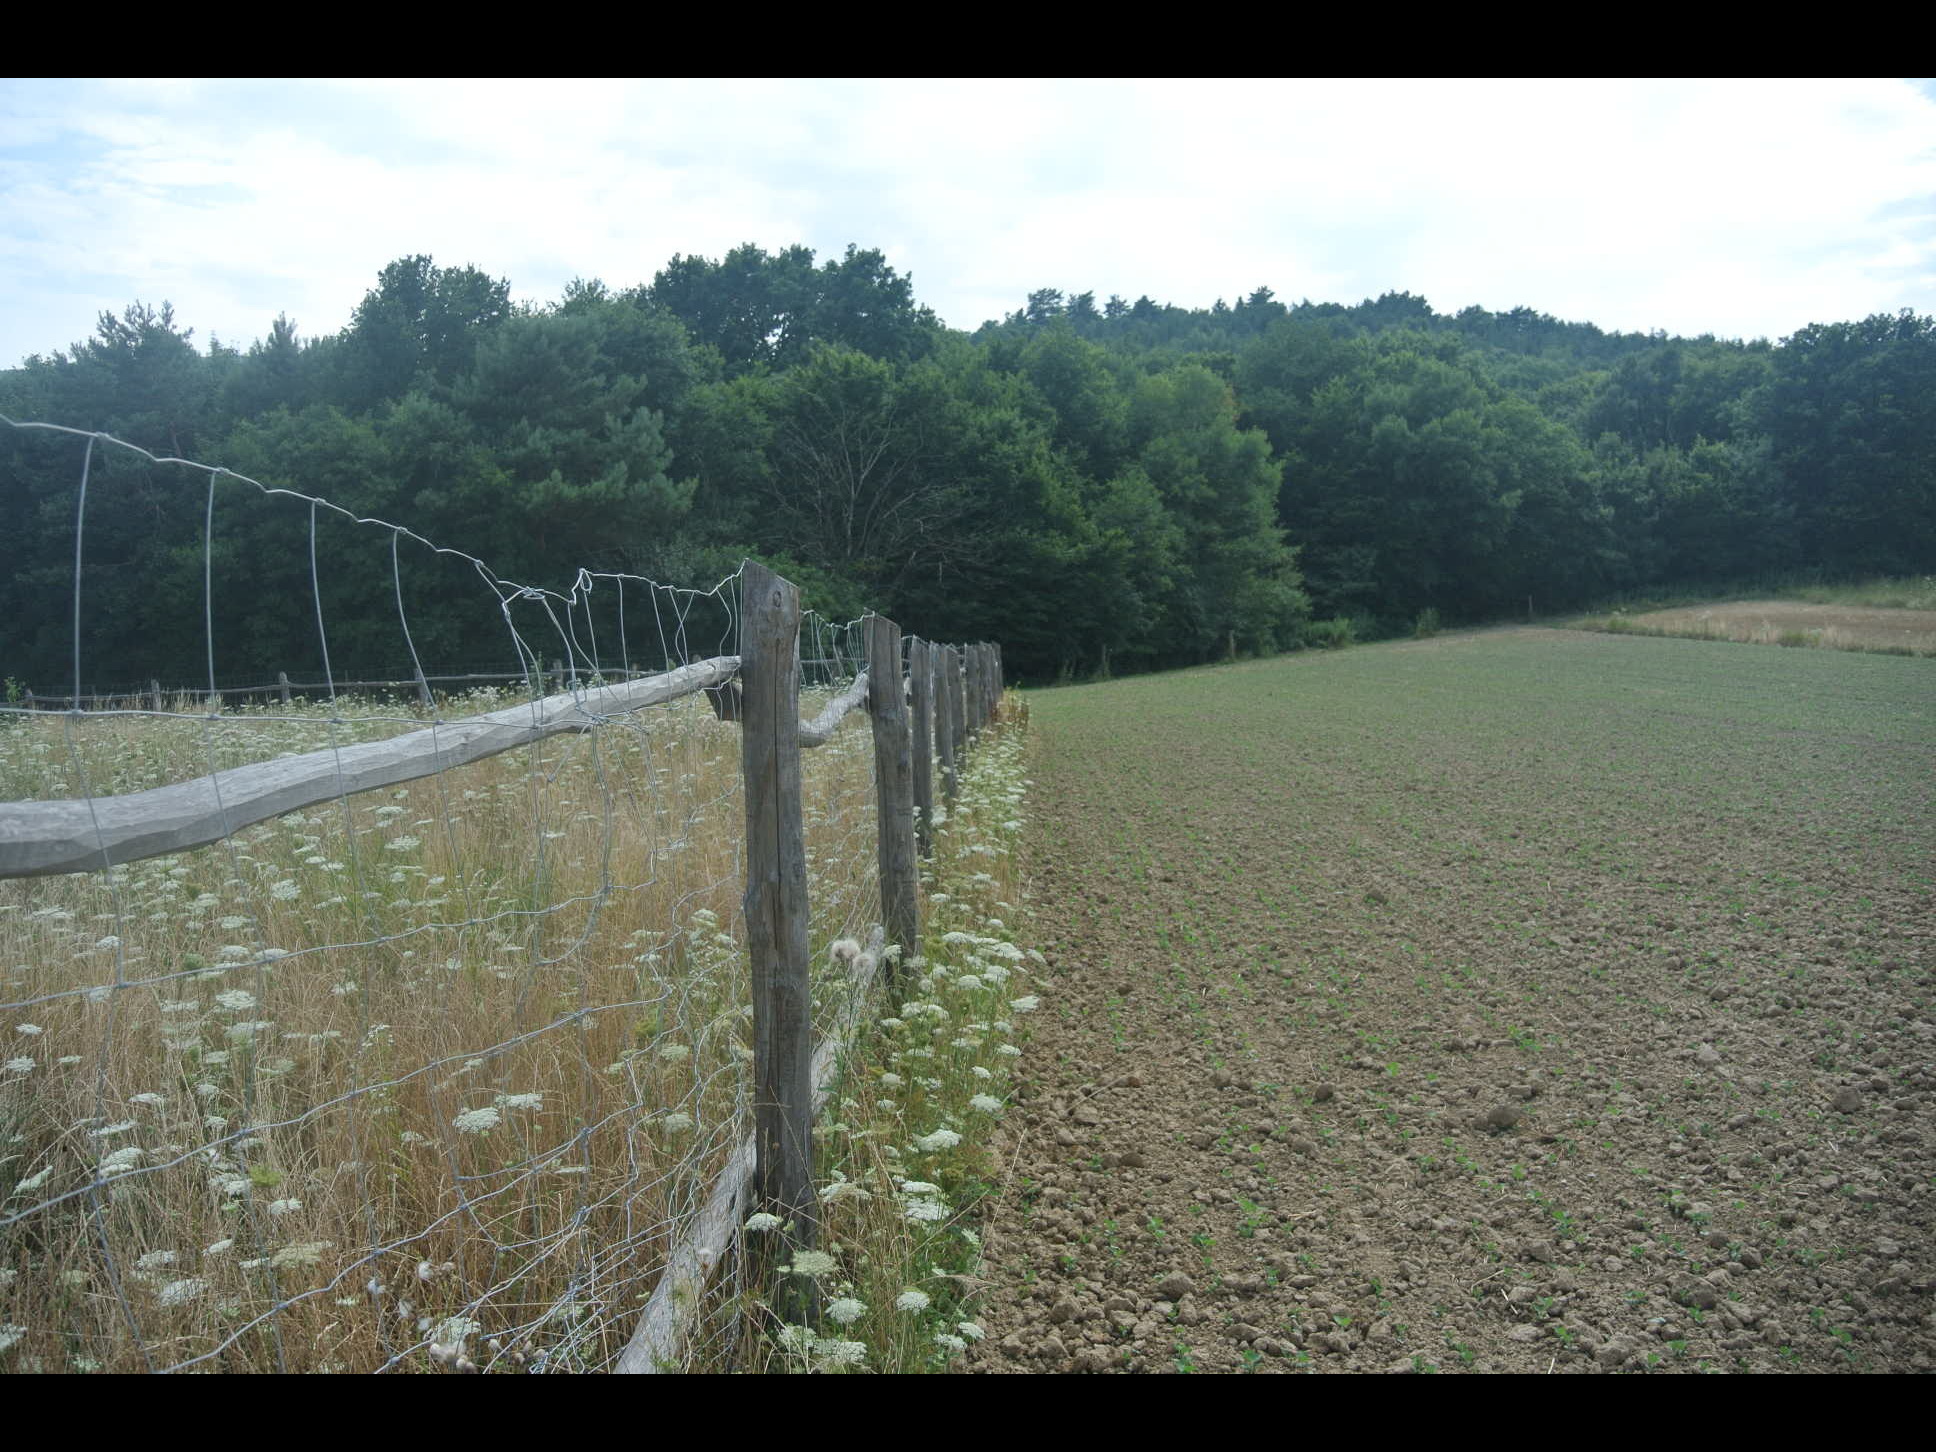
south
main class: Cropland
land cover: Apple fruit
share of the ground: < 10 %
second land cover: Grassland without tree/shrub cover
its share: > 75 %
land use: Agriculture (excluding fallow land and kitchen gardens)
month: July
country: AT
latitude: 47.4187
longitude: 16.4852
